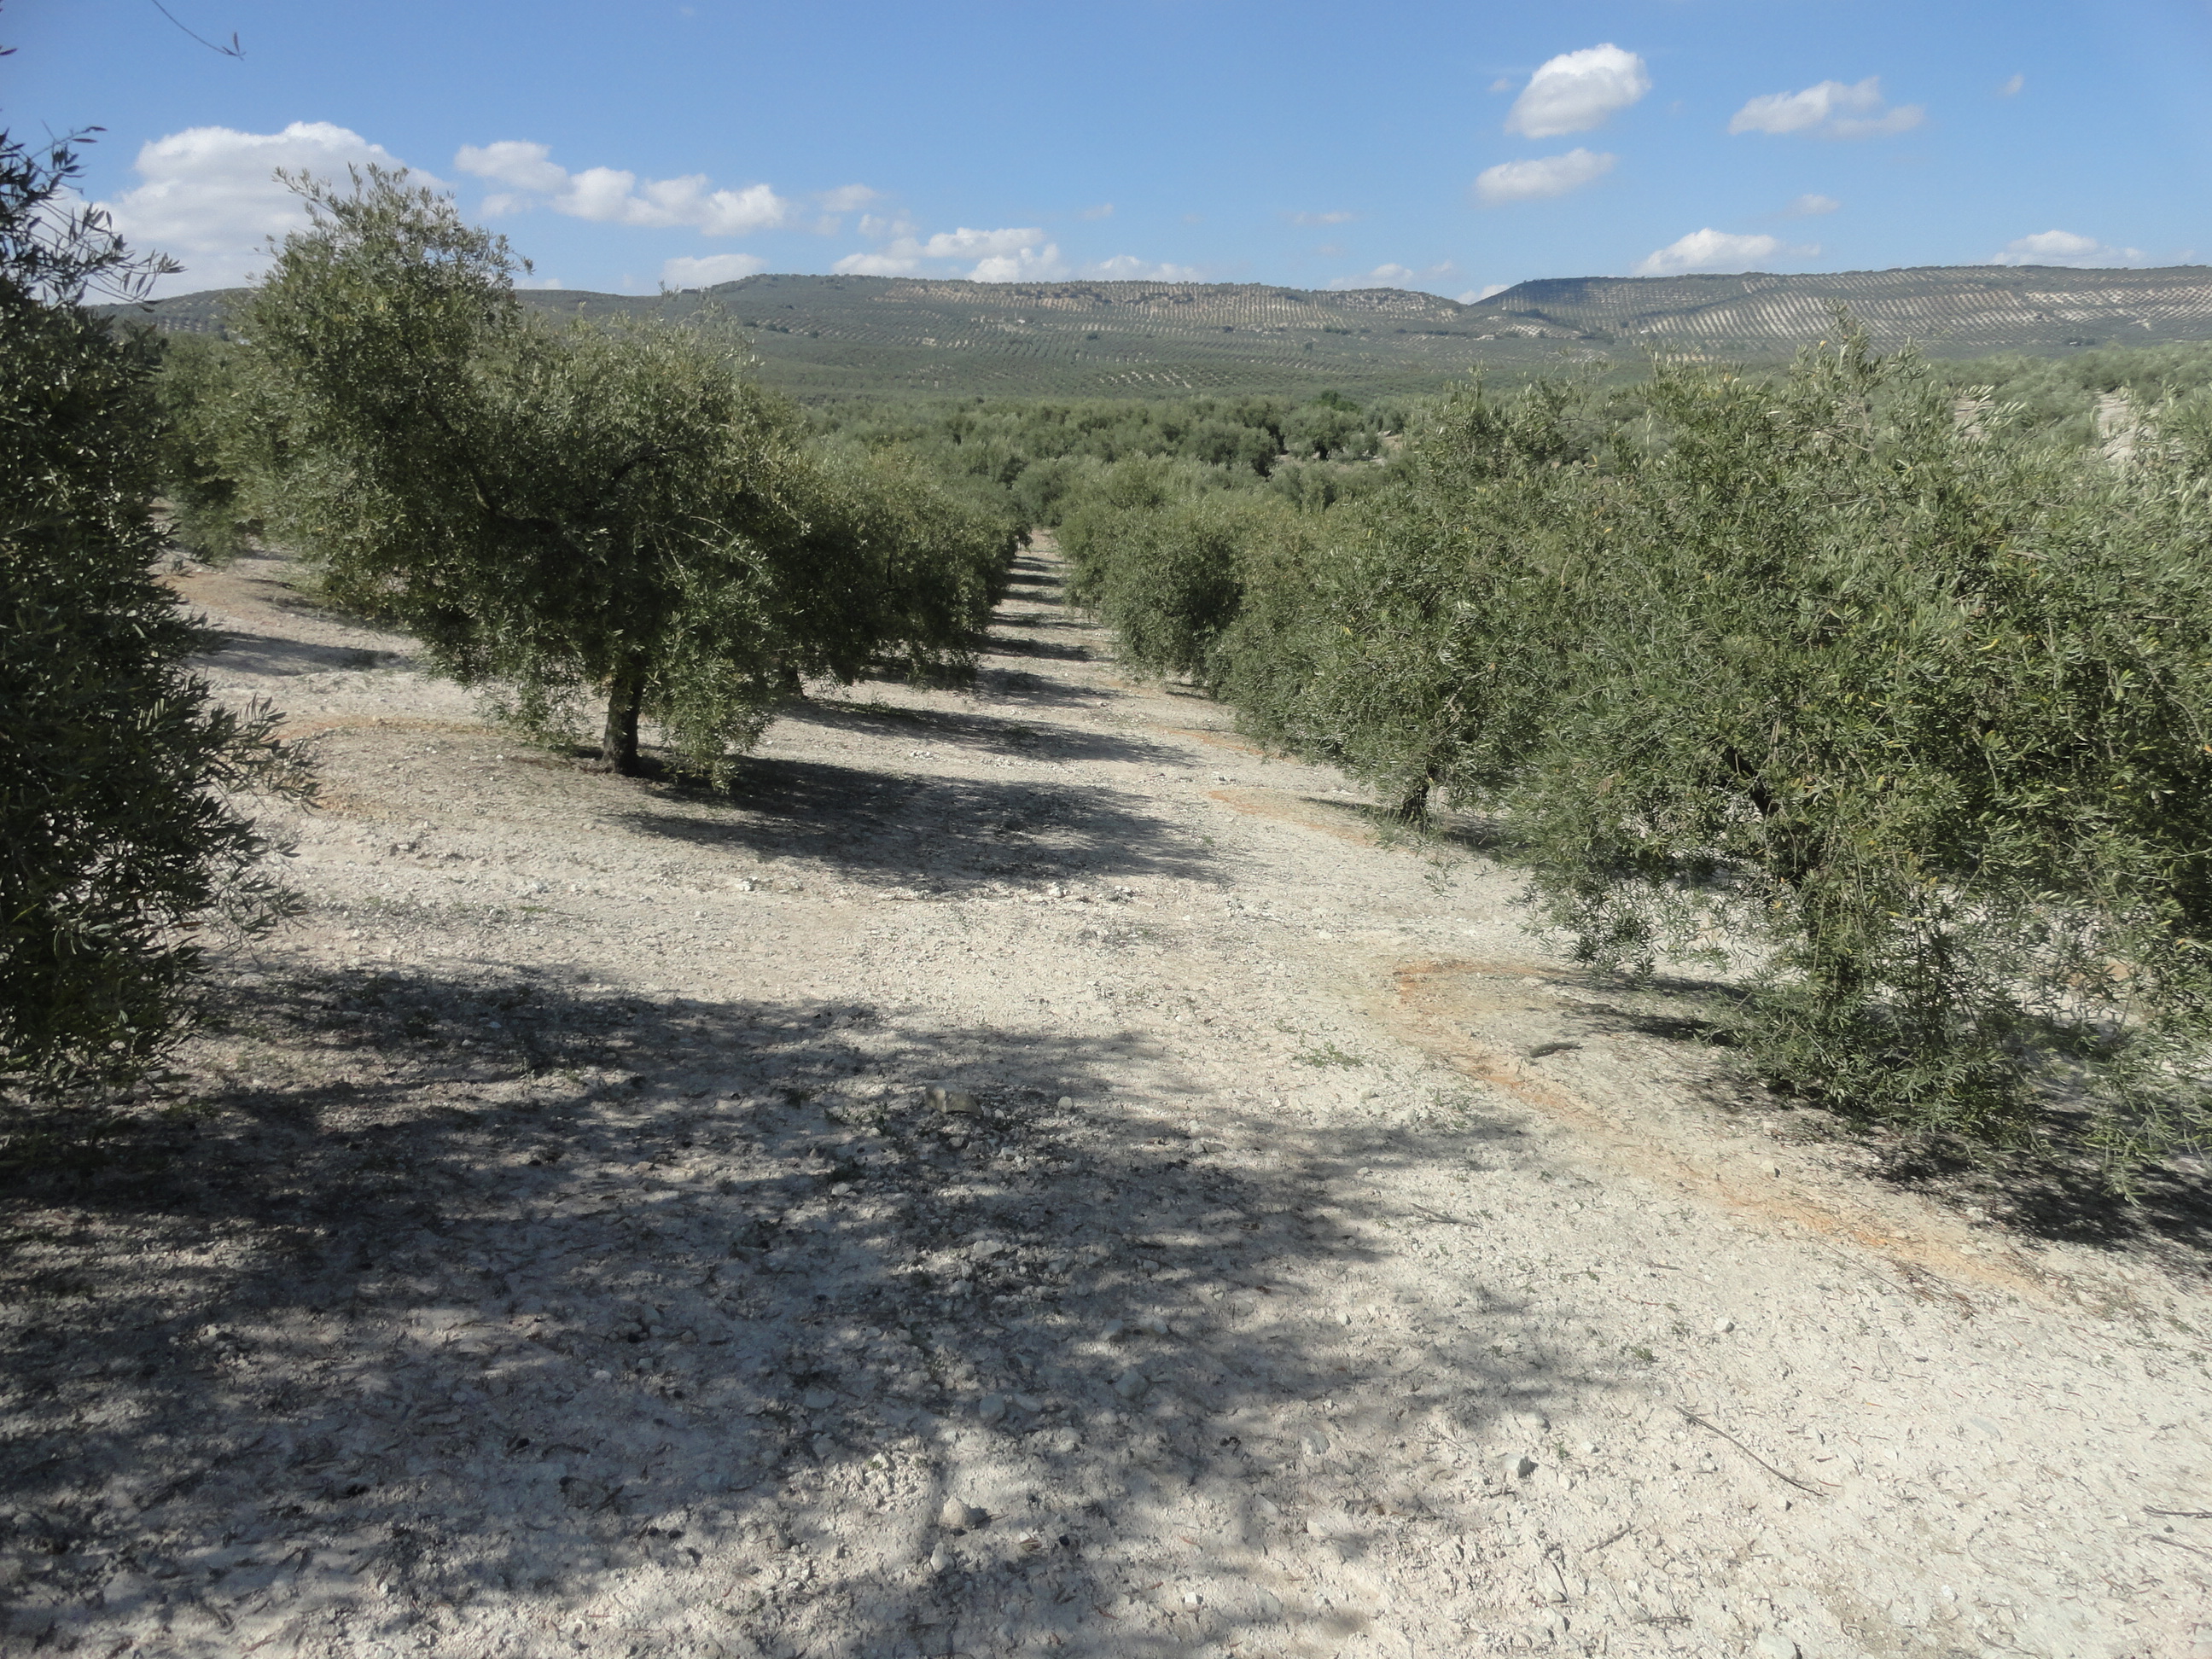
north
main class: Cropland
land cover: Olive groves
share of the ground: 50 - 75 %
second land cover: Other bare soil
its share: > 75 %
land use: Agriculture (excluding fallow land and kitchen gardens)
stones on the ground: 10 - 25 %
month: April
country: ES
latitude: 37.5341
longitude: -4.4787
